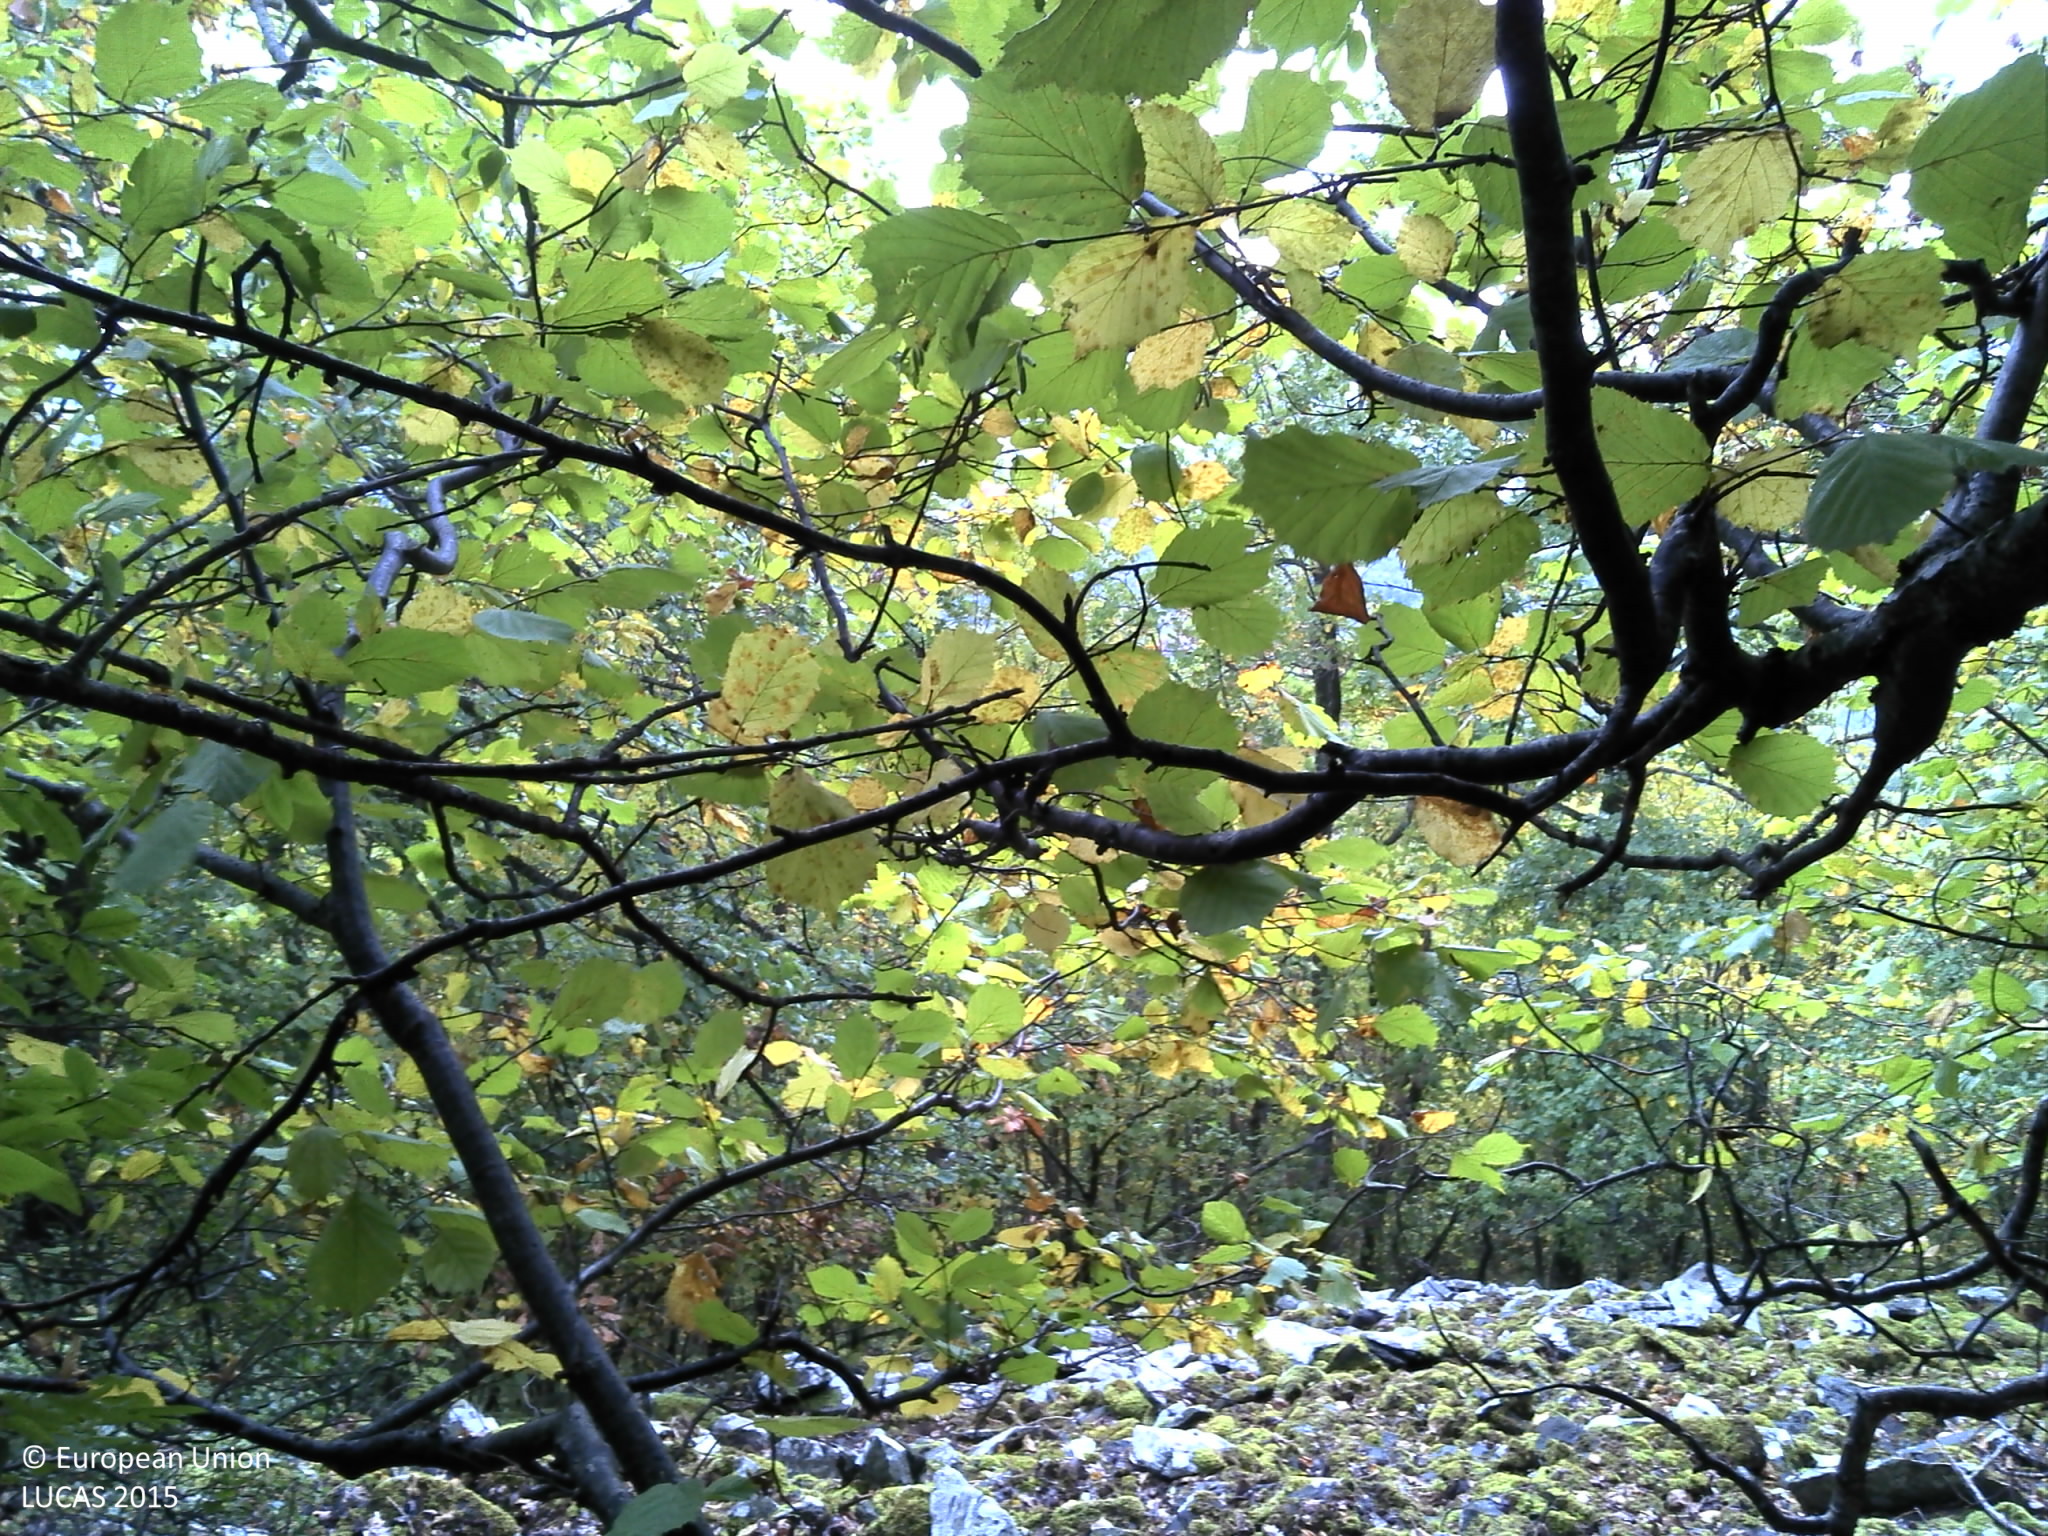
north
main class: Woodland
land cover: Broadleaved woodland
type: mesophytic deciduous forest
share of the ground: > 75 %
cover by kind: broadleaved forest trees 90 %, herbaceous plants 5 %, lichens and mosses 5 %
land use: Forestry
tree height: < 5 m
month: October
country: FR
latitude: 45.4436
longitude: 3.1355
